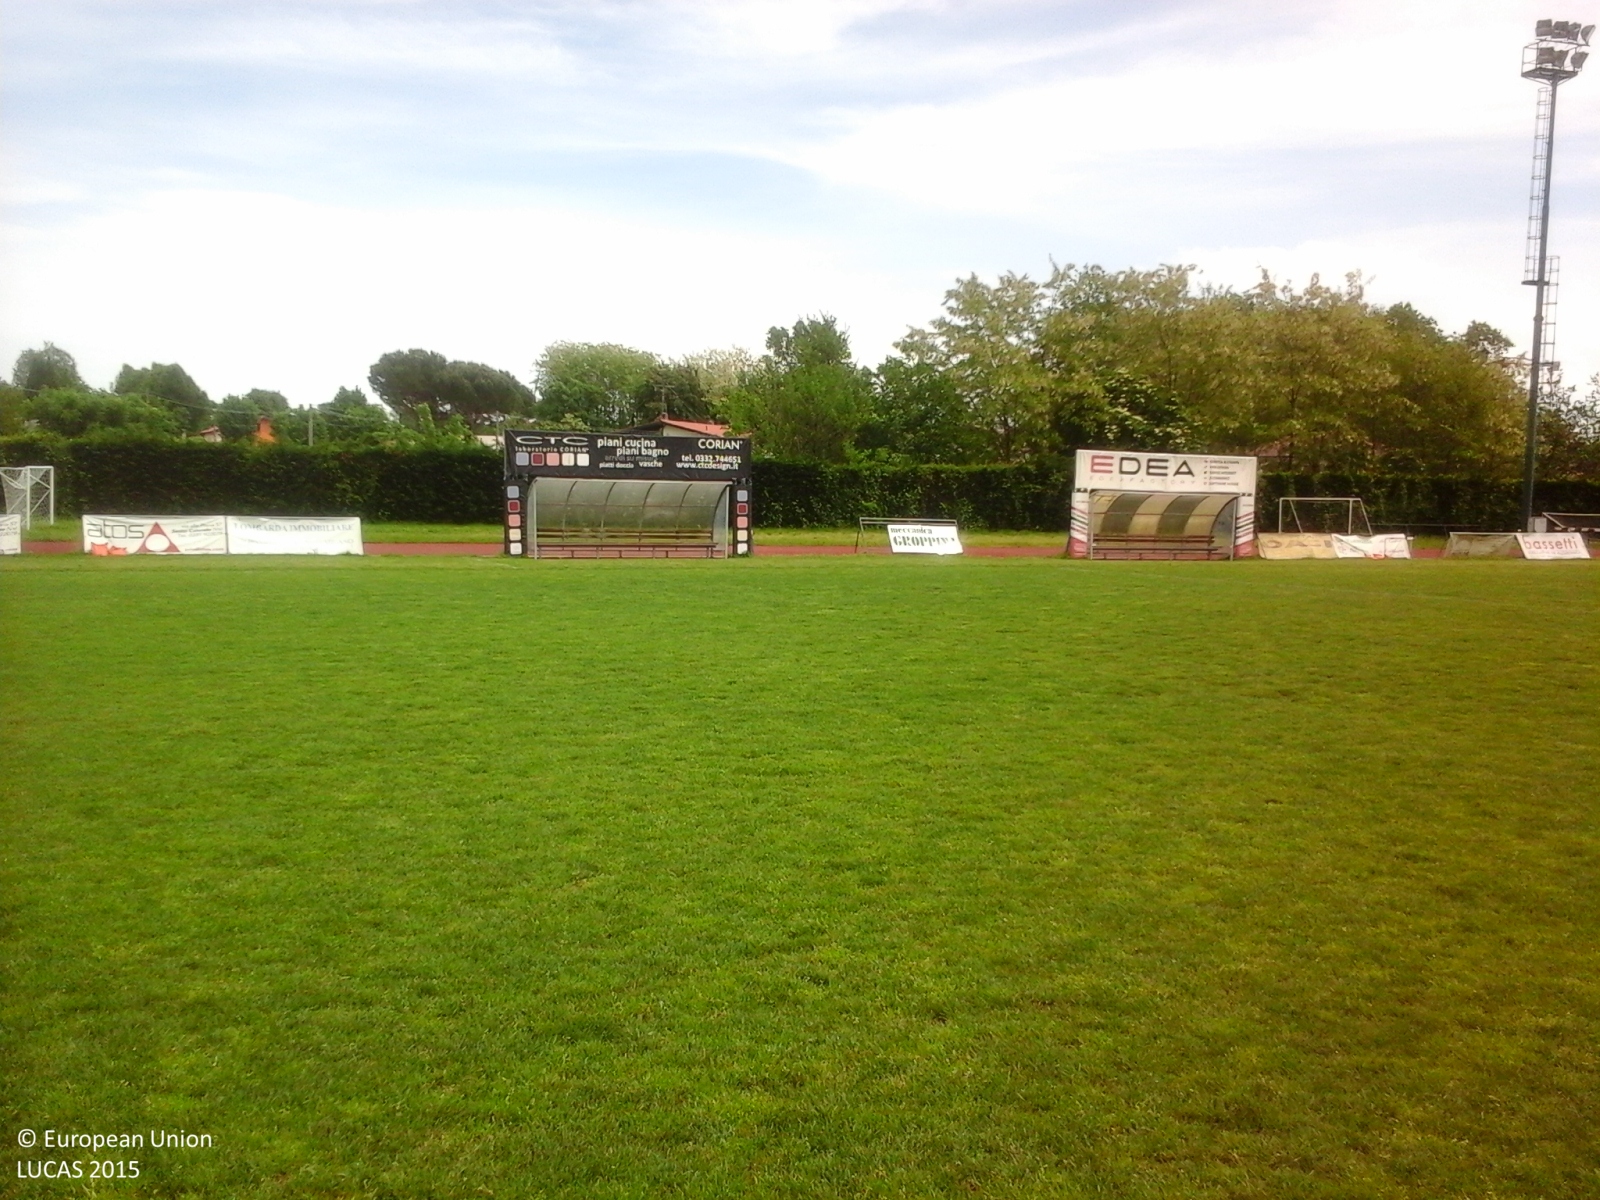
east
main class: Grassland
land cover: Grassland without tree/shrub cover
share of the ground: > 75 %
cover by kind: herbaceous plants 100 %
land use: Sport
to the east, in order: Grassland without tree/shrub cover; Artificial constructions in urban areas; Other bare soil; Artificial constructions in urban areas
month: May
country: IT
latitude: 45.7298
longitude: 8.6272
